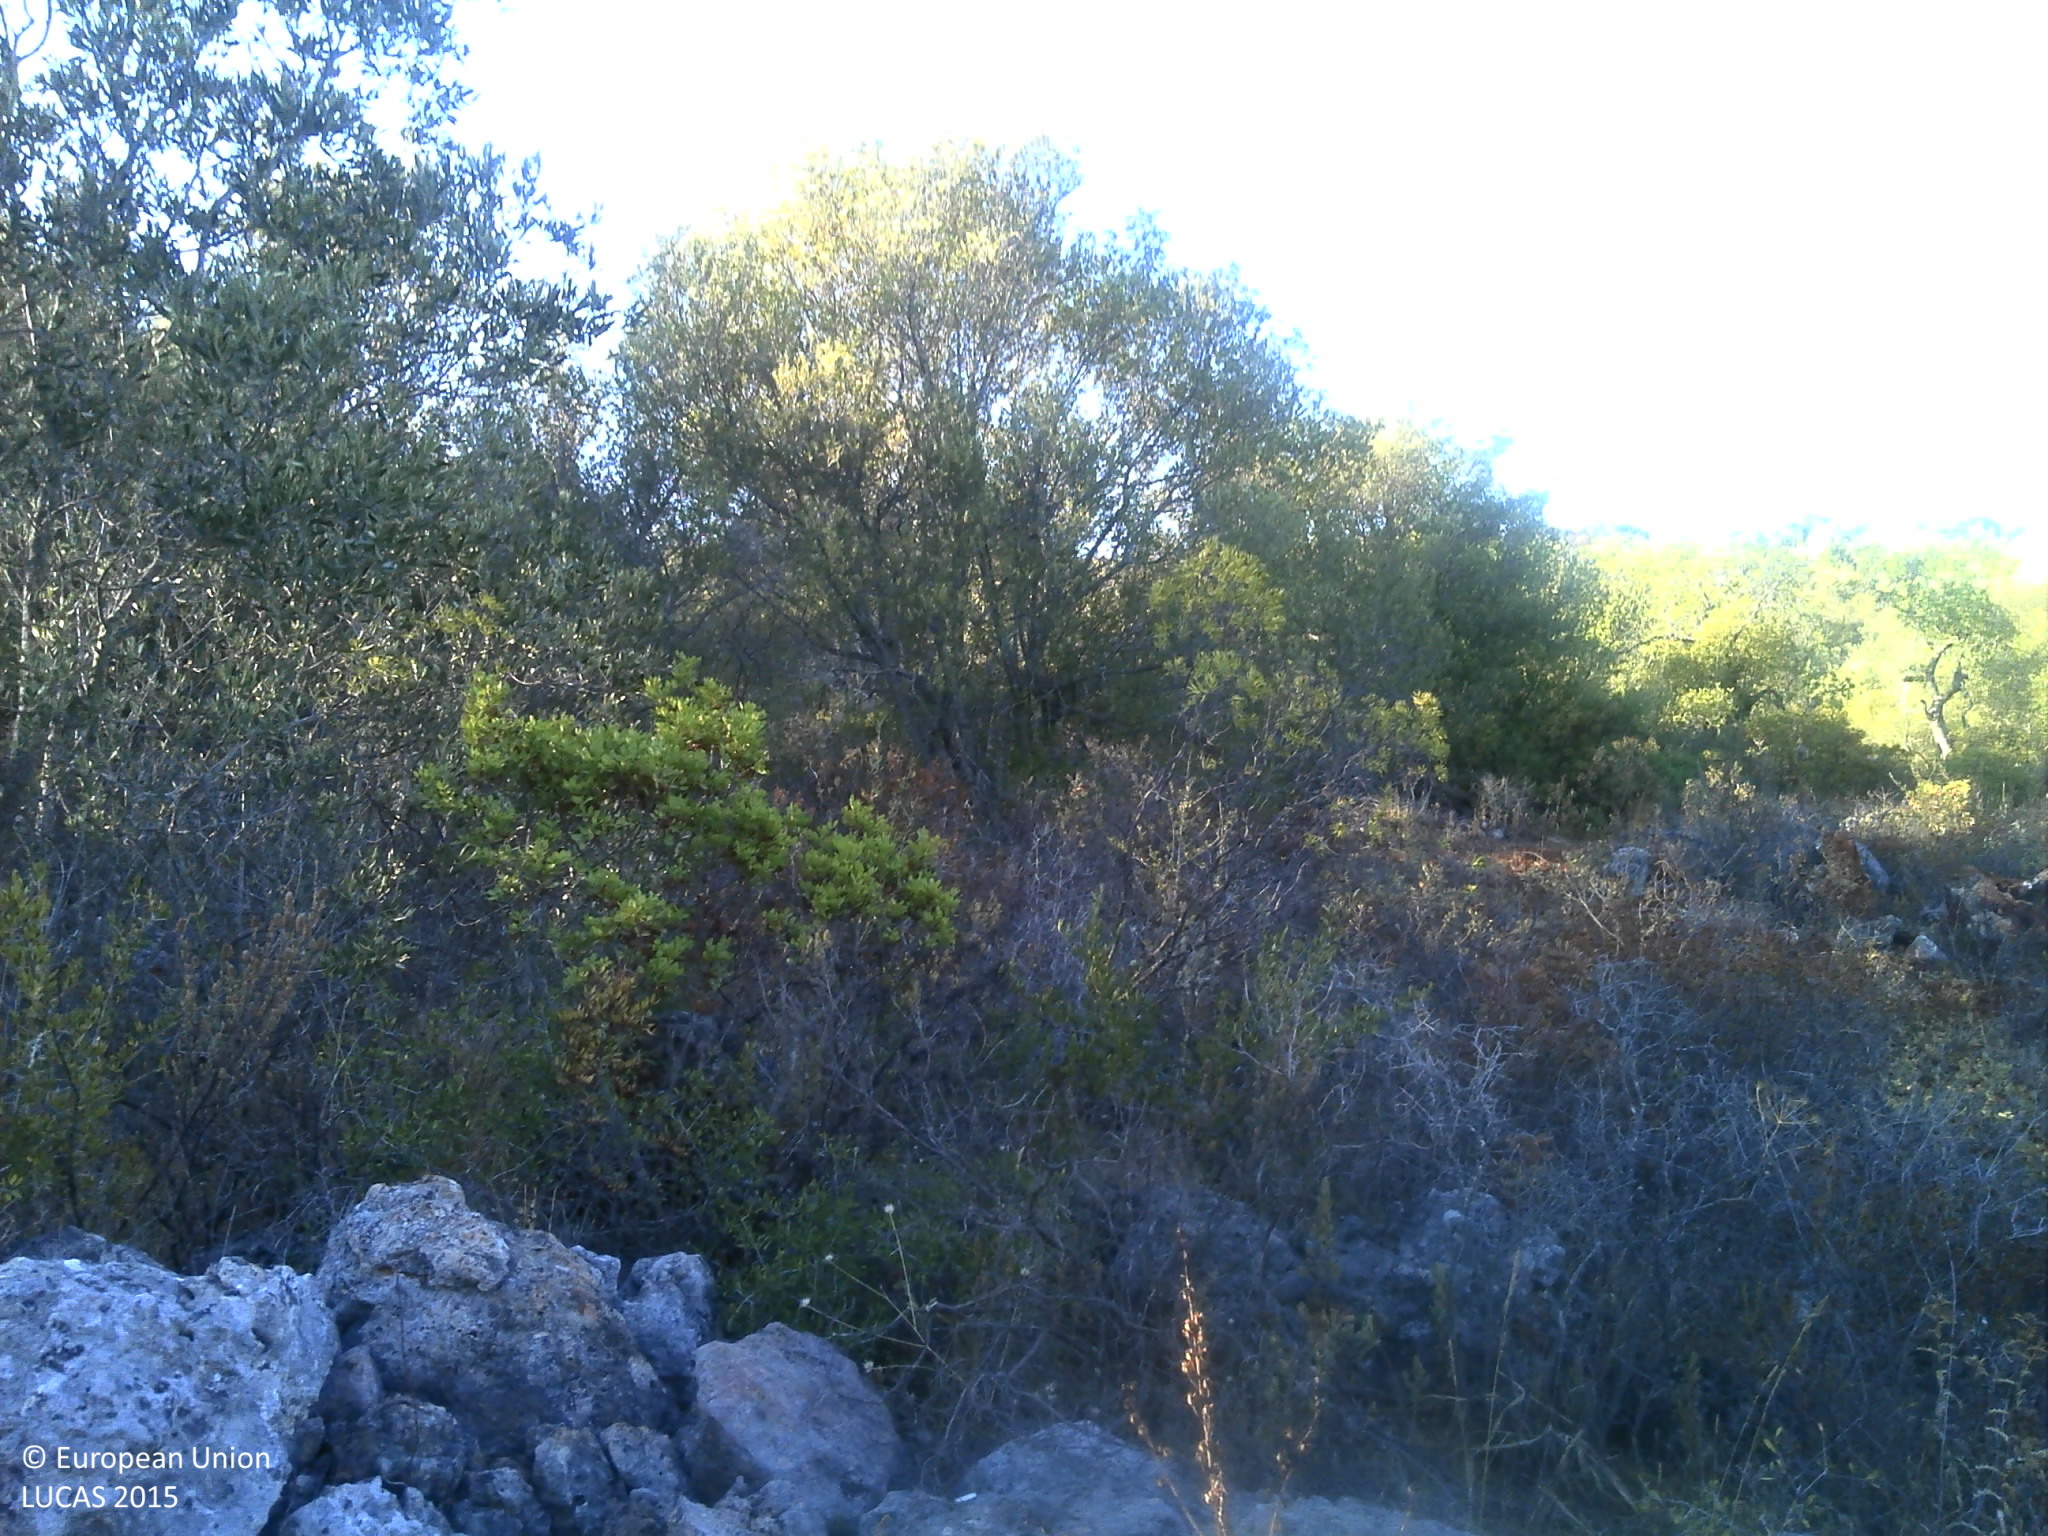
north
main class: Shrubland
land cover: Shrubland with sparse tree cover
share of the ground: 50 - 75 %
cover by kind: shrubs 50 %, unconsolidated bare surface 40 %, broadleaved forest trees 5 %, herbaceous plants 5 %
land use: Abandoned areas
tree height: < 5 m
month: September
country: PT
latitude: 37.2299
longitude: -8.1303
